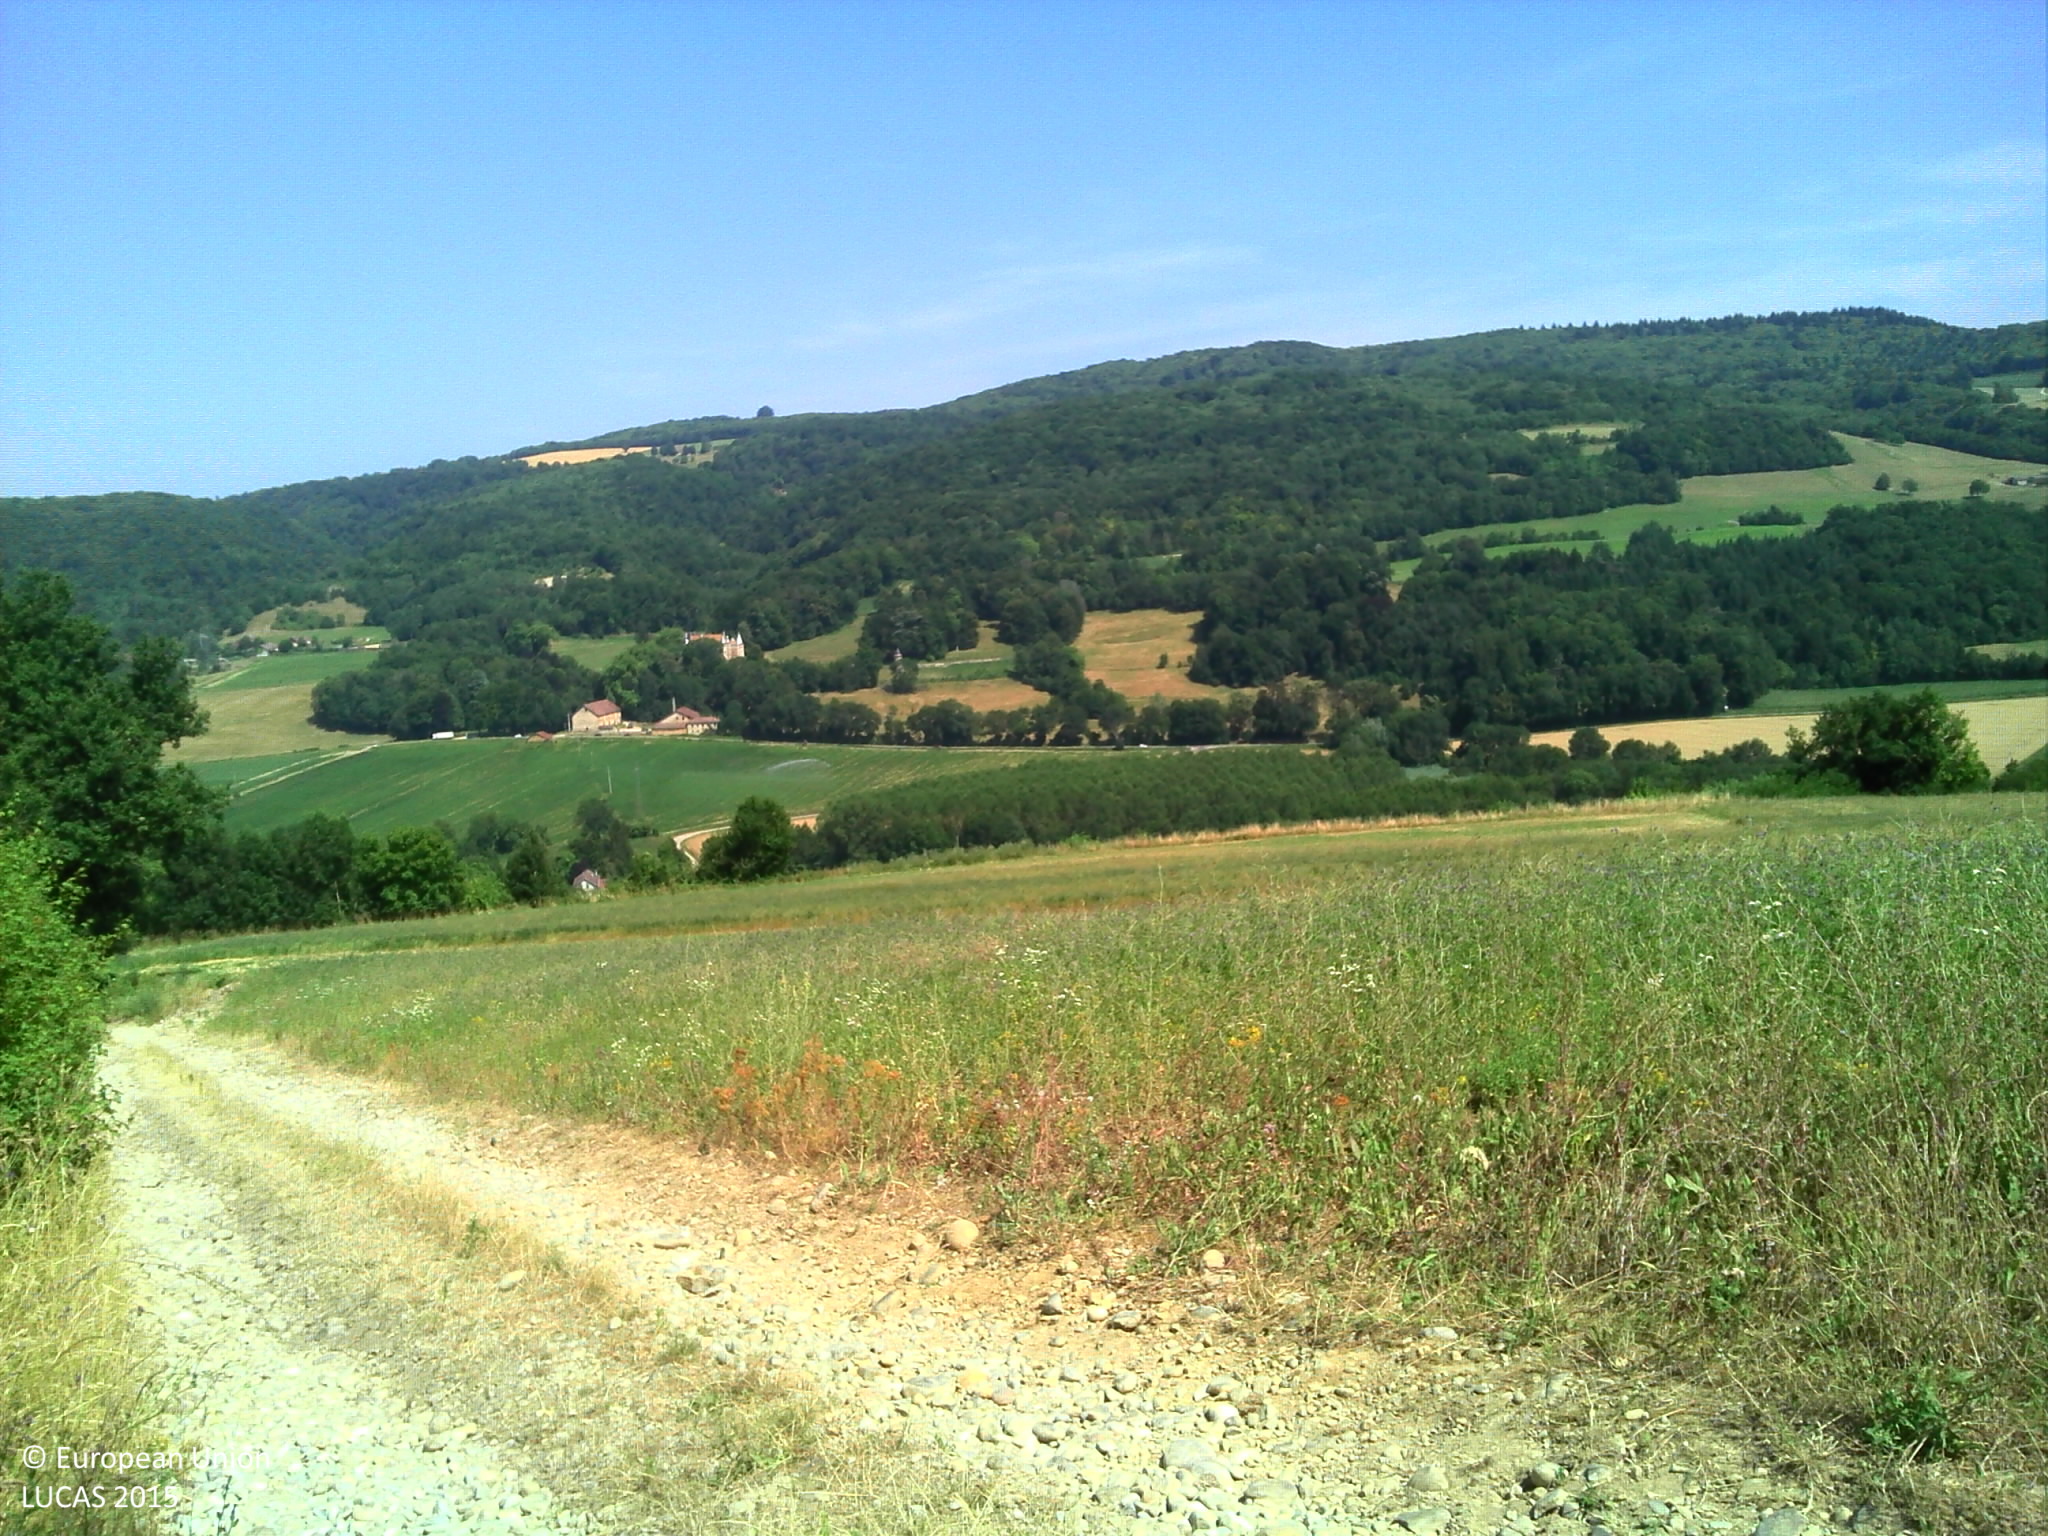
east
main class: Grassland
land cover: Grassland without tree/shrub cover
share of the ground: > 75 %
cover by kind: herbaceous plants 100 %
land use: Agriculture (excluding fallow land and kitchen gardens)
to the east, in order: Grassland without tree/shrub cover; Fences; Abandoned hedges; Tracks; Managed hedges; Other leguminous and mixtures for fodder; Broadleaved woodland; Railways; Broadleaved woodland; Fences; Grassland without tree/shrub cover
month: July
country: FR
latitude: 45.4600
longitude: 5.4392
